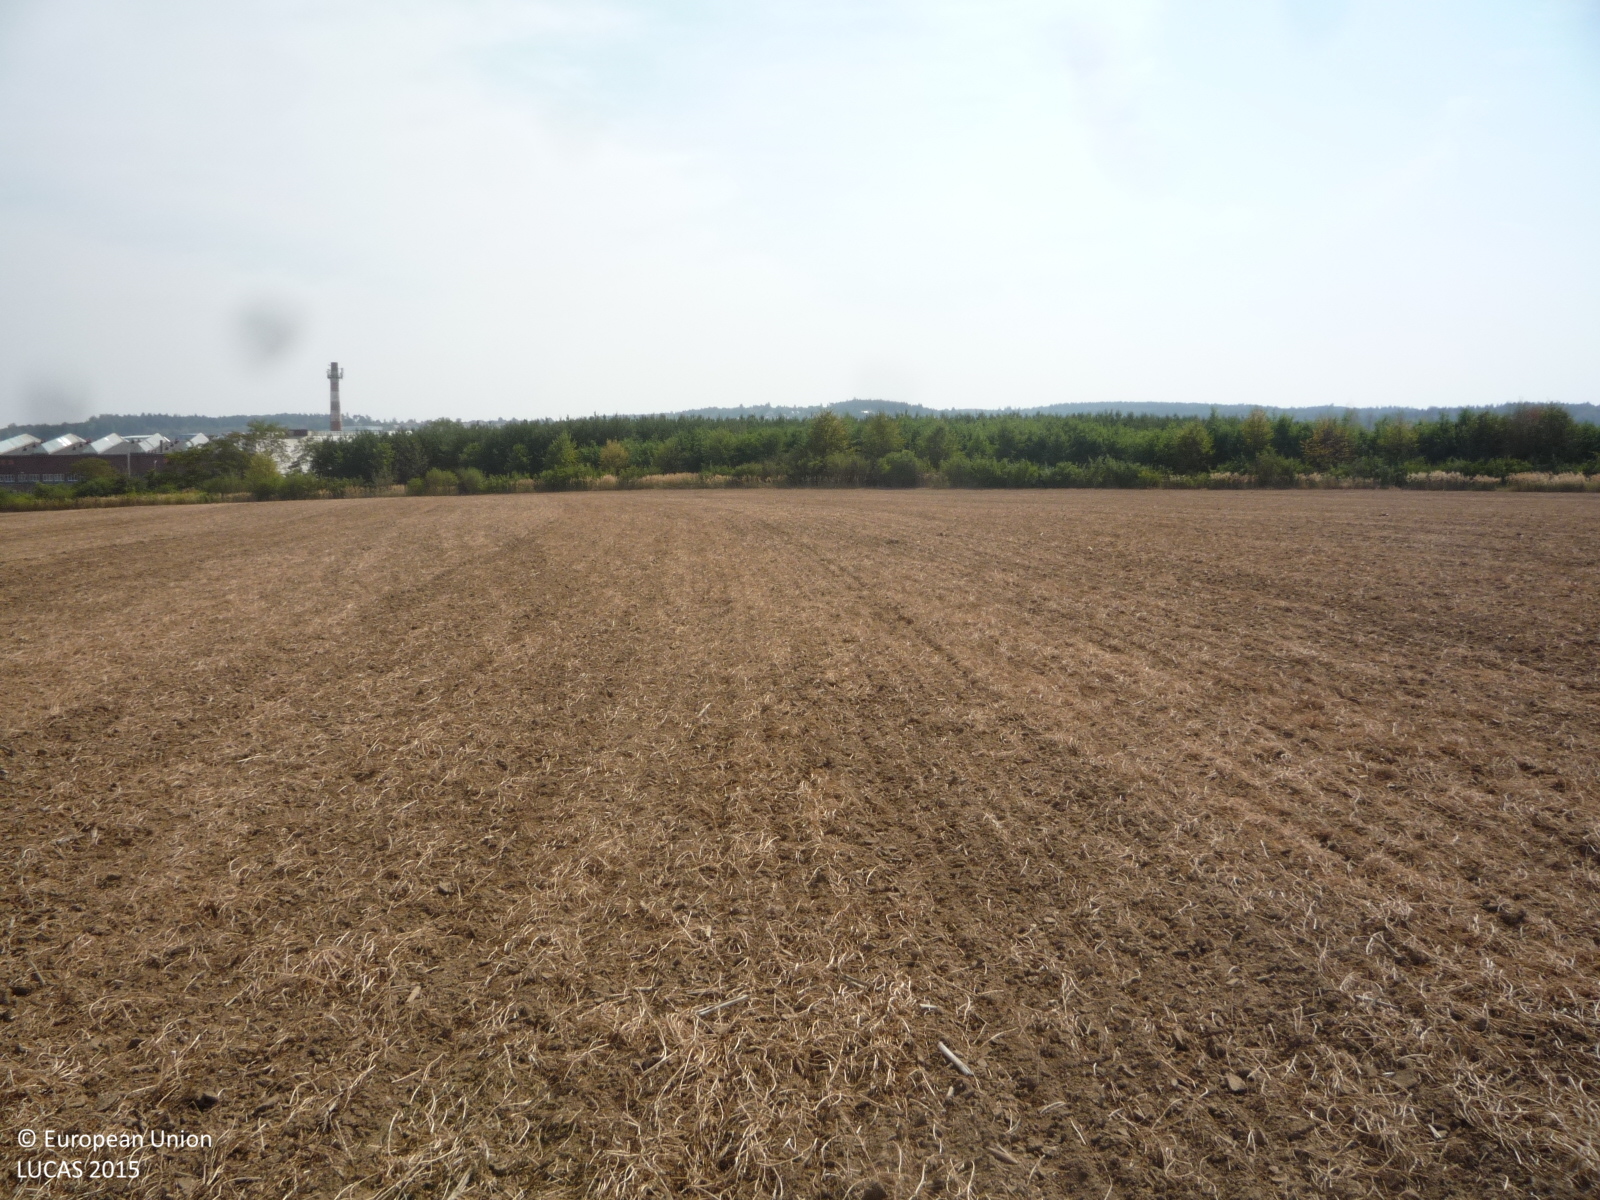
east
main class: Cropland
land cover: Dry pulses
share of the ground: < 10 %
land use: Agriculture (excluding fallow land and kitchen gardens)
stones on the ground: < 10 %
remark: Harvested field
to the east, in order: Dry pulses; Shrubland with sparse tree cover; Fences; Pine dominated coniferous woodland; Fences; Broadleaved woodland; Shrubland without tree cover; Spontaneously vegetated surfaces
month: August
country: CZ
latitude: 49.9512
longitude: 14.5033
